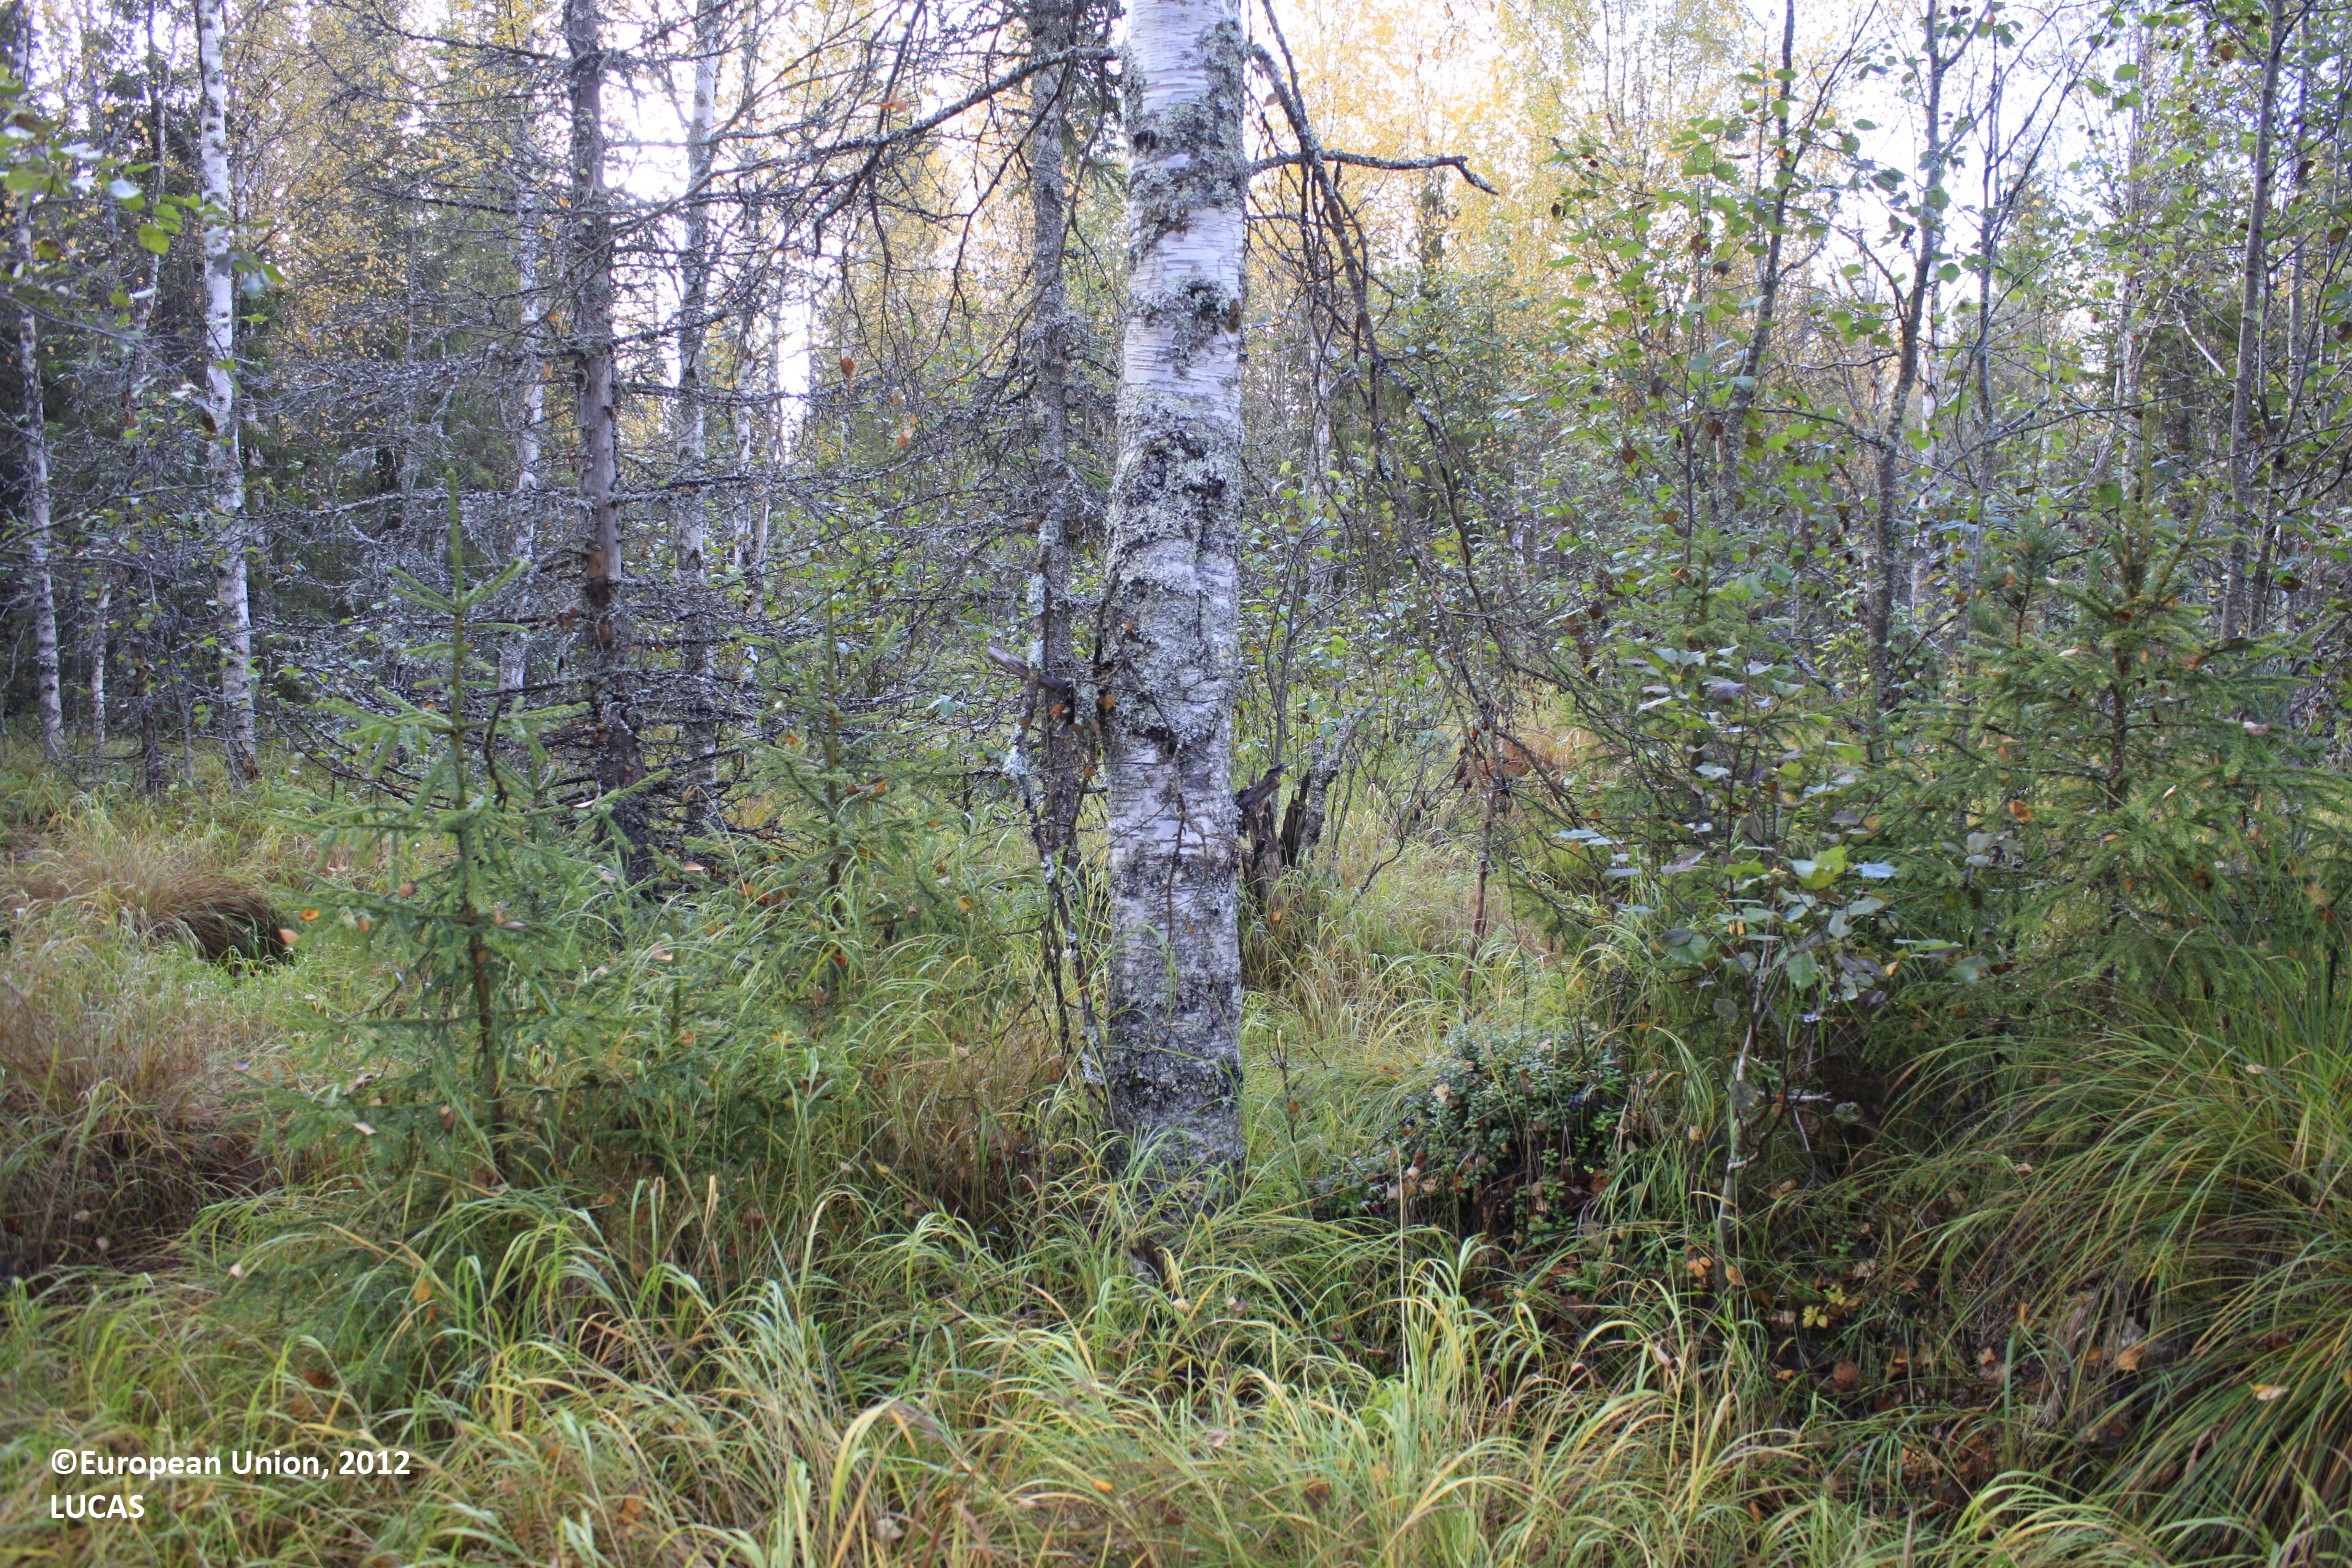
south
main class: Woodland
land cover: Spruce dominated mixed woodland
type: mire and swamp forests
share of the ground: 25 - 50 %
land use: Semi-natural and natural areas not in use
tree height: > 5 m
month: September
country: FI
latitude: 65.5929
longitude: 27.3215
